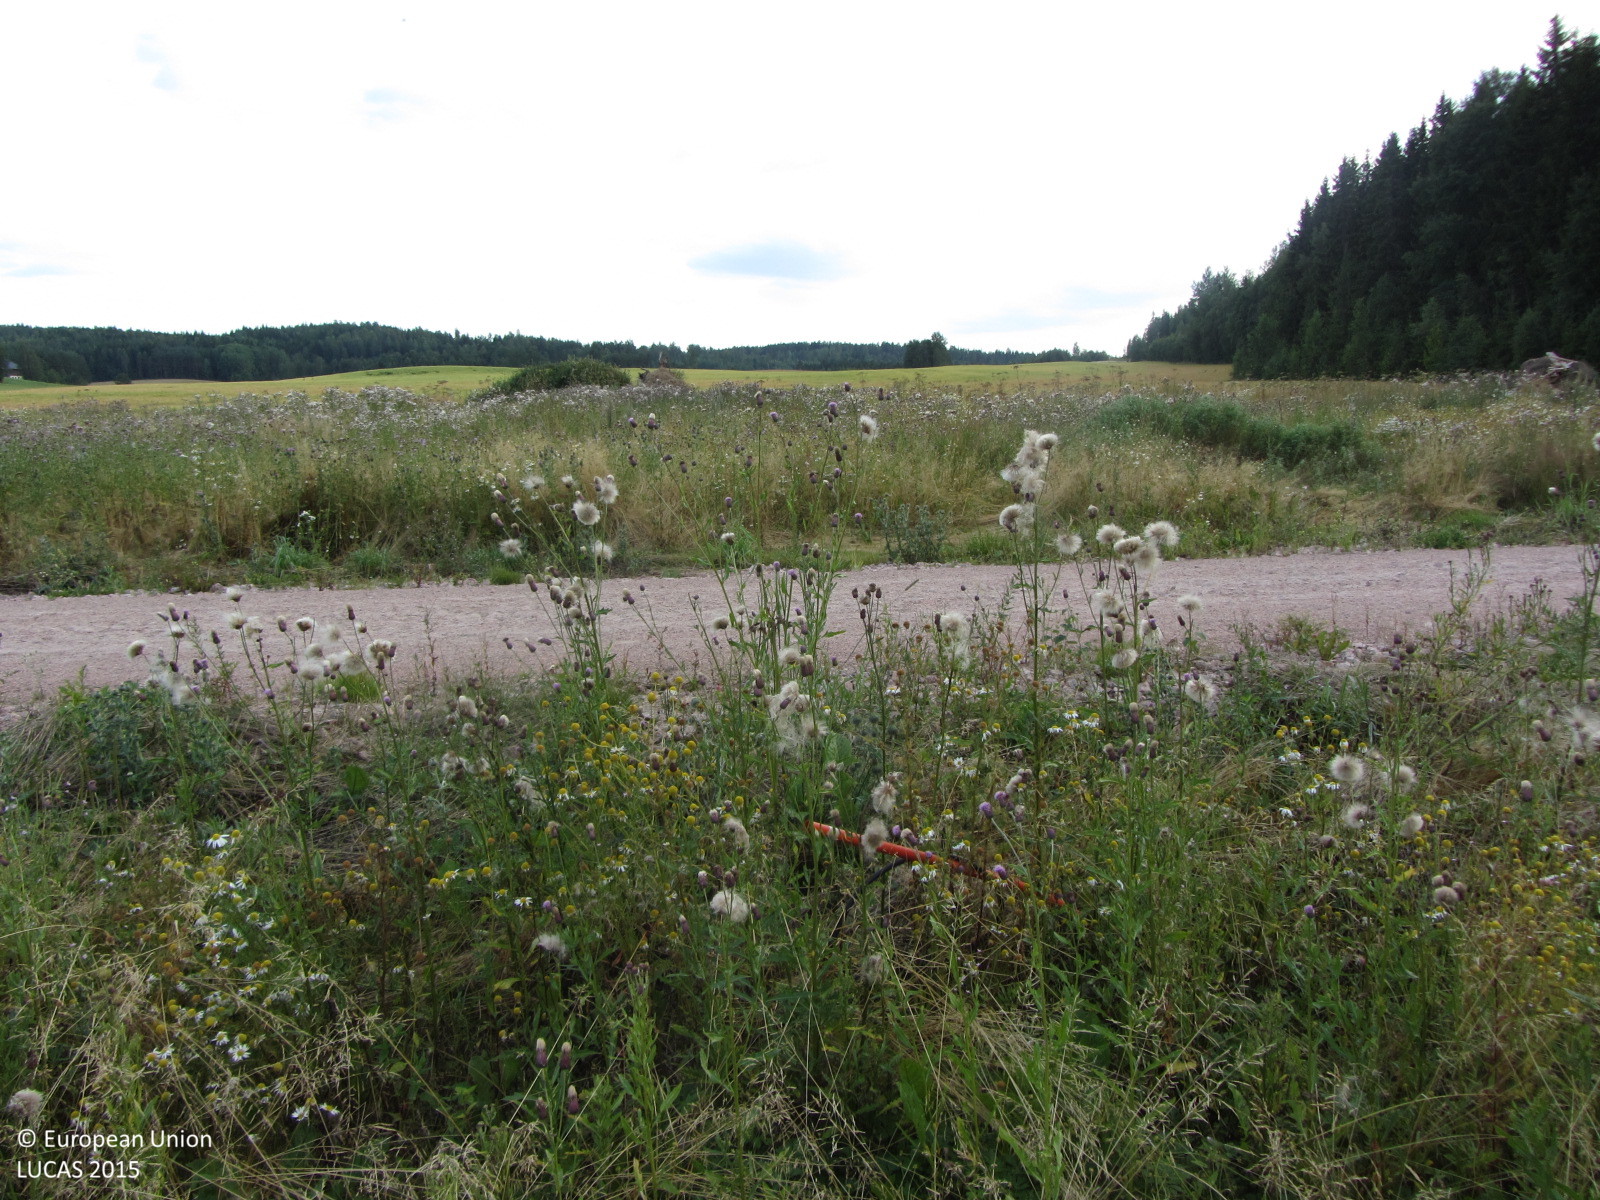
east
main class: Grassland
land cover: Spontaneously vegetated surfaces
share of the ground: > 75 %
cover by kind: herbaceous plants 100 %
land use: Fallow land
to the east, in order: Spontaneously vegetated surfaces; Tracks; Spontaneously vegetated surfaces; Ditches and canals; Grass margins; Rape and turnip rape
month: August
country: FI
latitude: 60.3708
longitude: 23.4880
